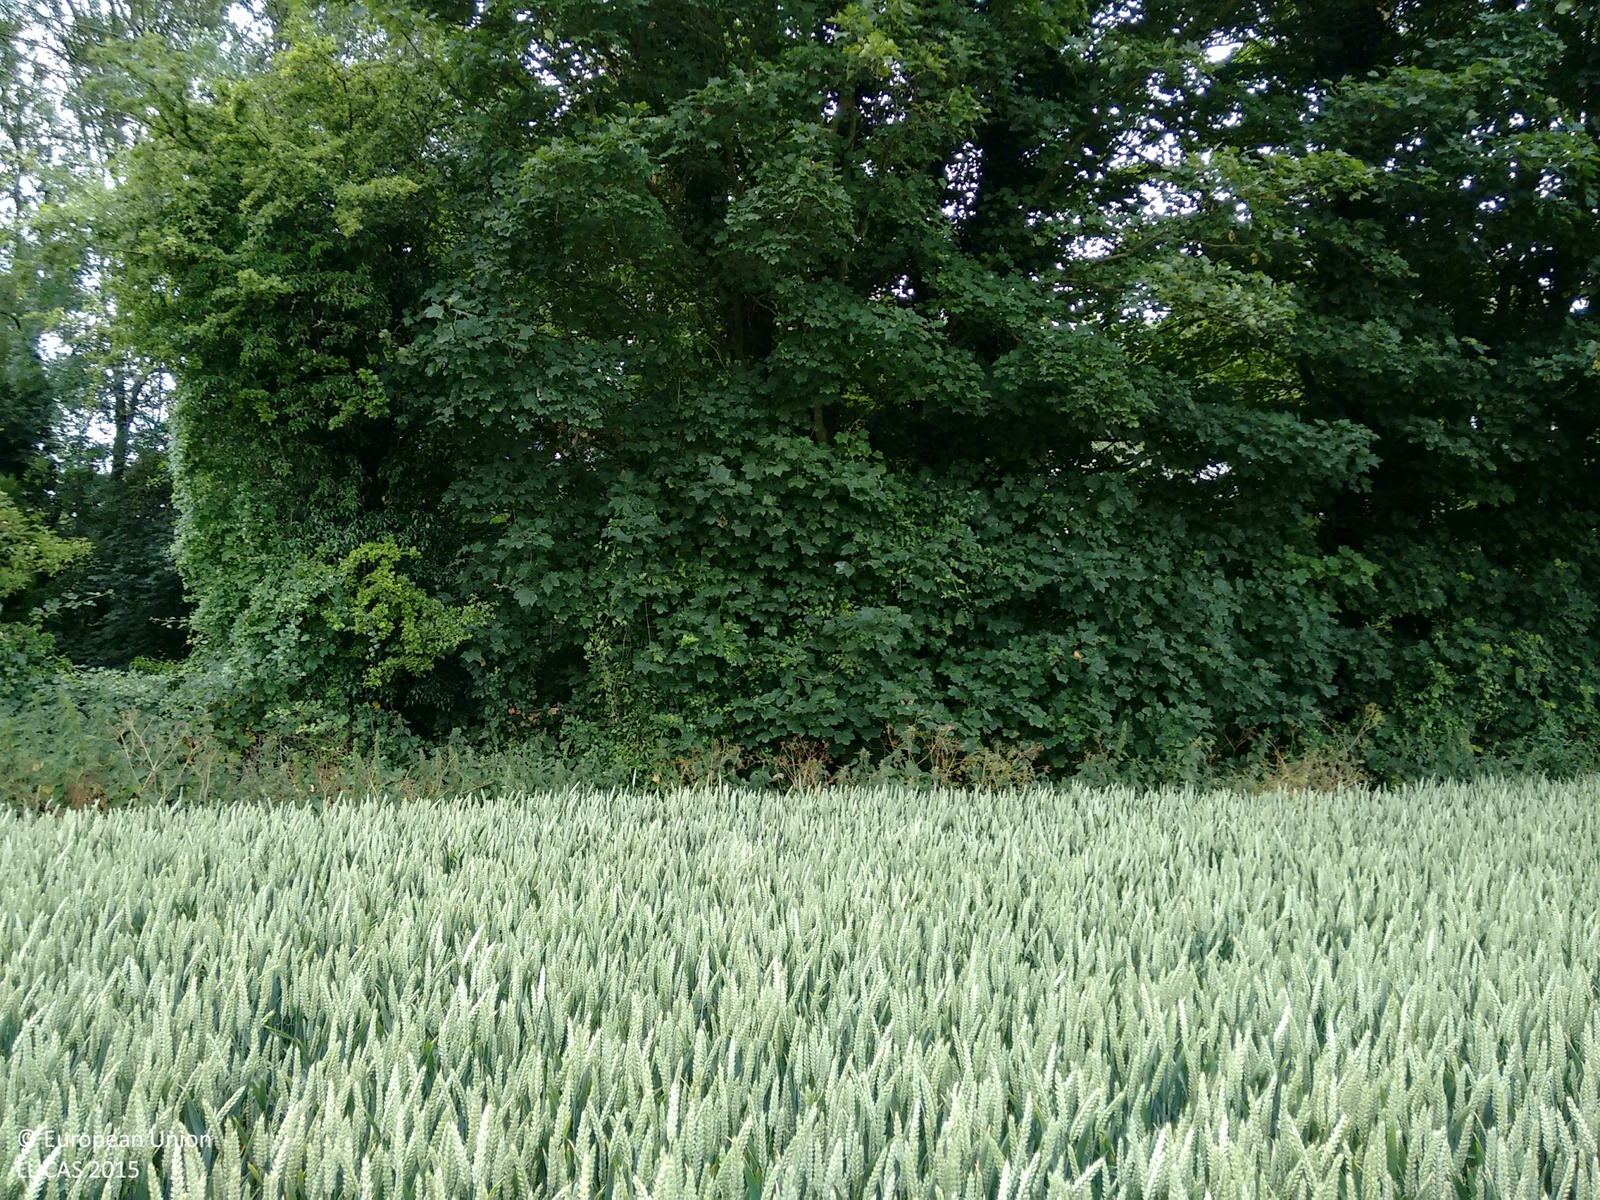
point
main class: Woodland
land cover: Broadleaved woodland
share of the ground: > 75 %
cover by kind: broadleaved forest trees 75 %, shrubs 15 %, herbaceous plants 10 %
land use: Agriculture (excluding fallow land and kitchen gardens)
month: July
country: GB
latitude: 51.7728
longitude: -1.5737
